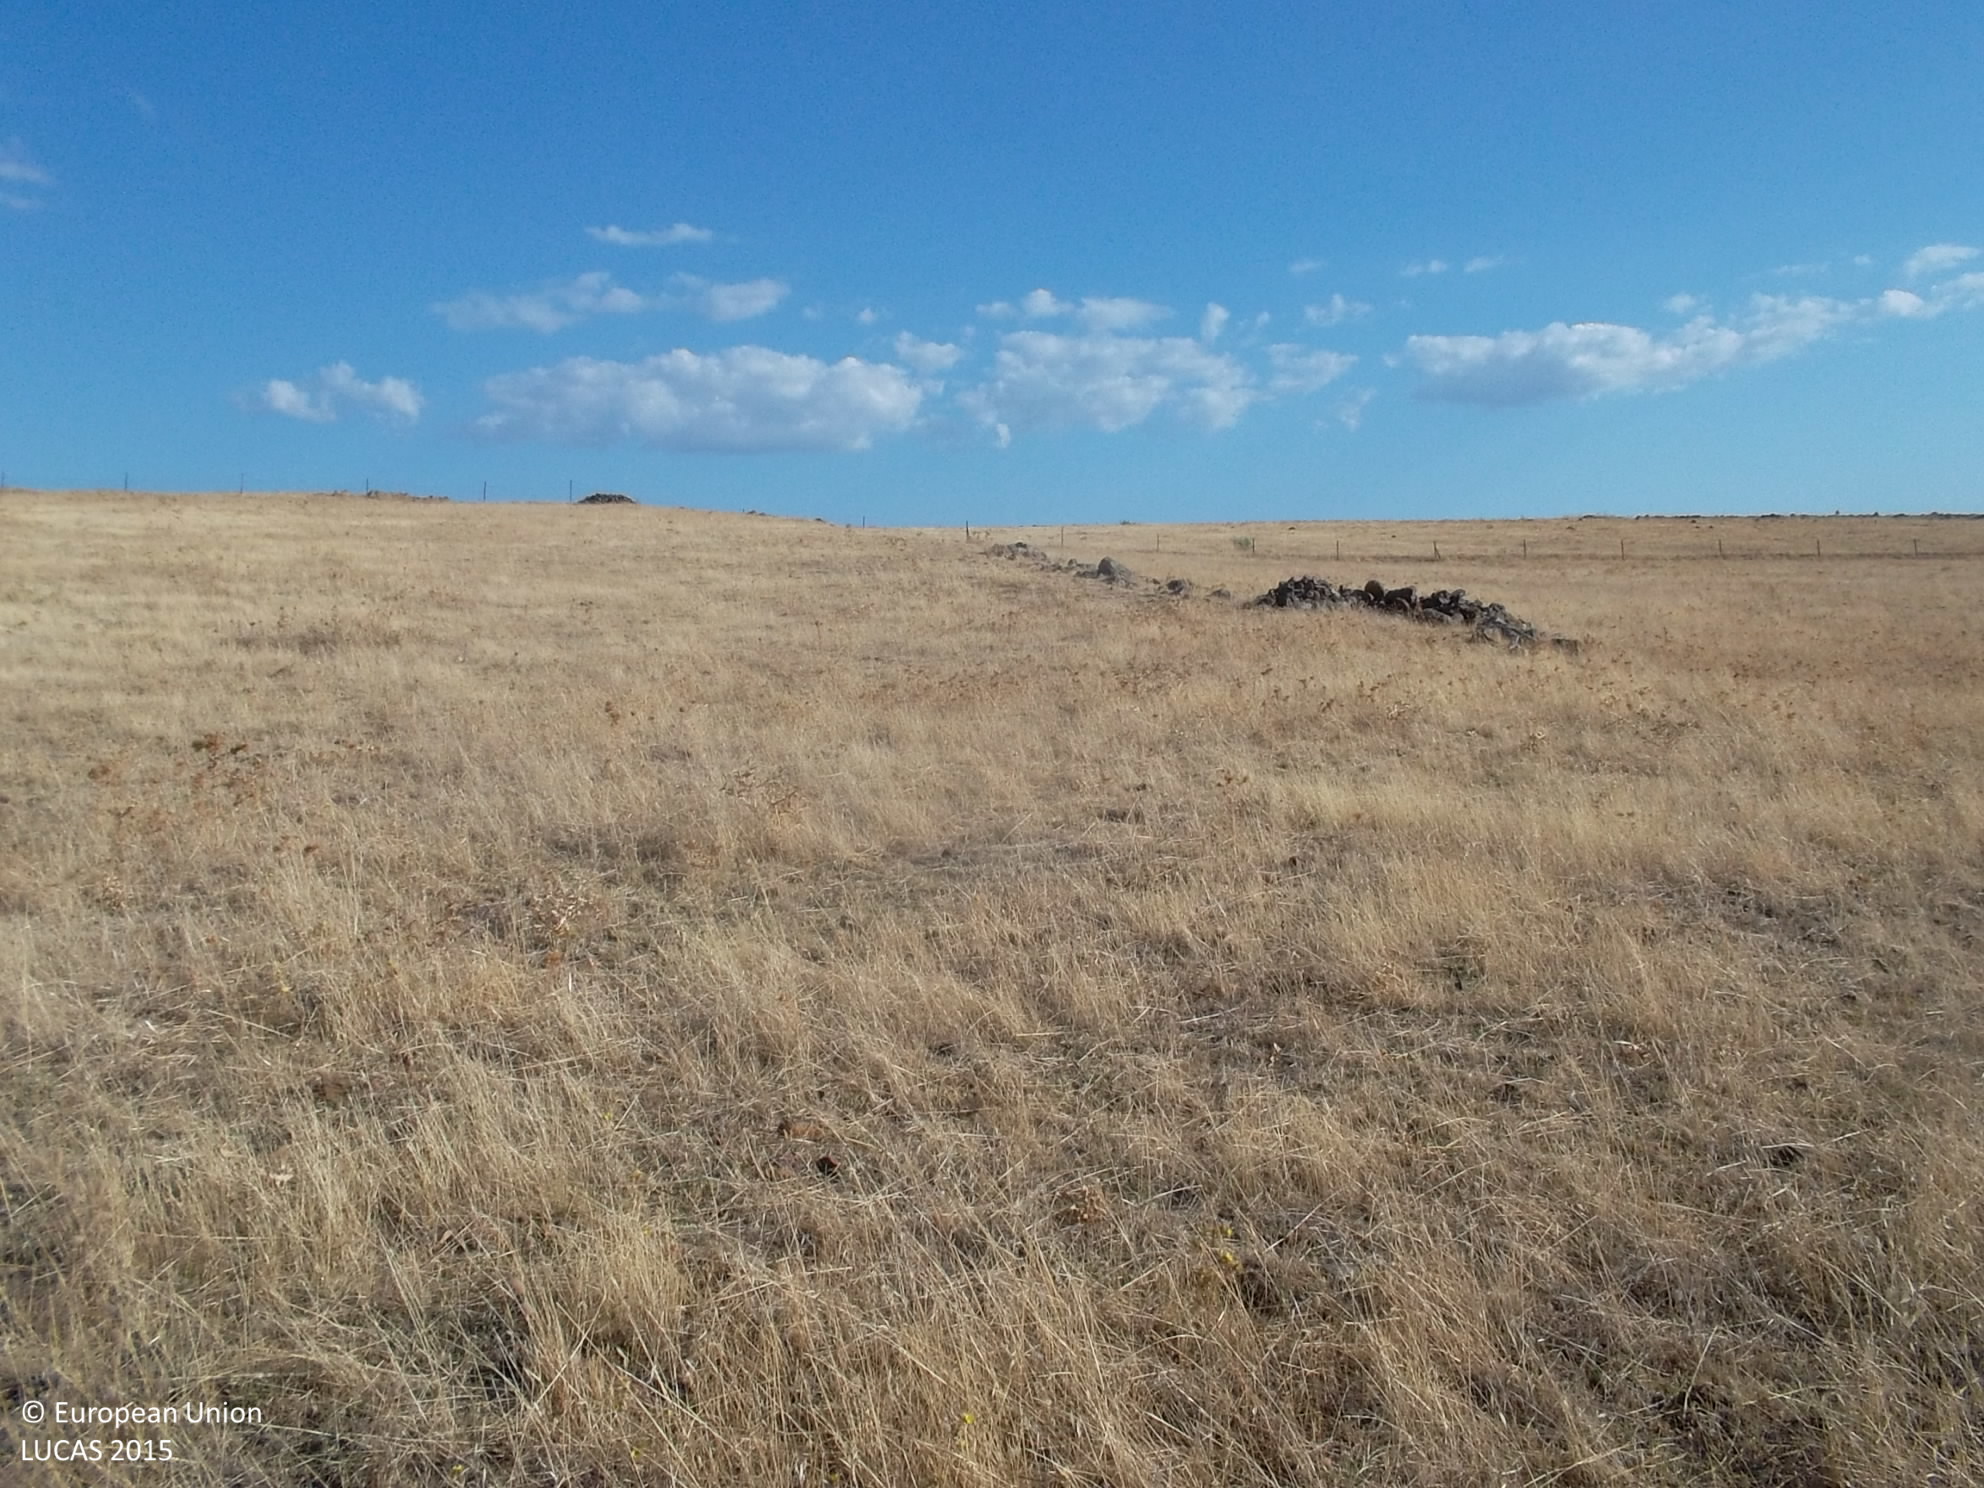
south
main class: Grassland
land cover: Spontaneously vegetated surfaces
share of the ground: > 75 %
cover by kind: herbaceous plants 100 %
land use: Fallow land
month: September
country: ES
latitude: 38.2365
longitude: -6.3722
